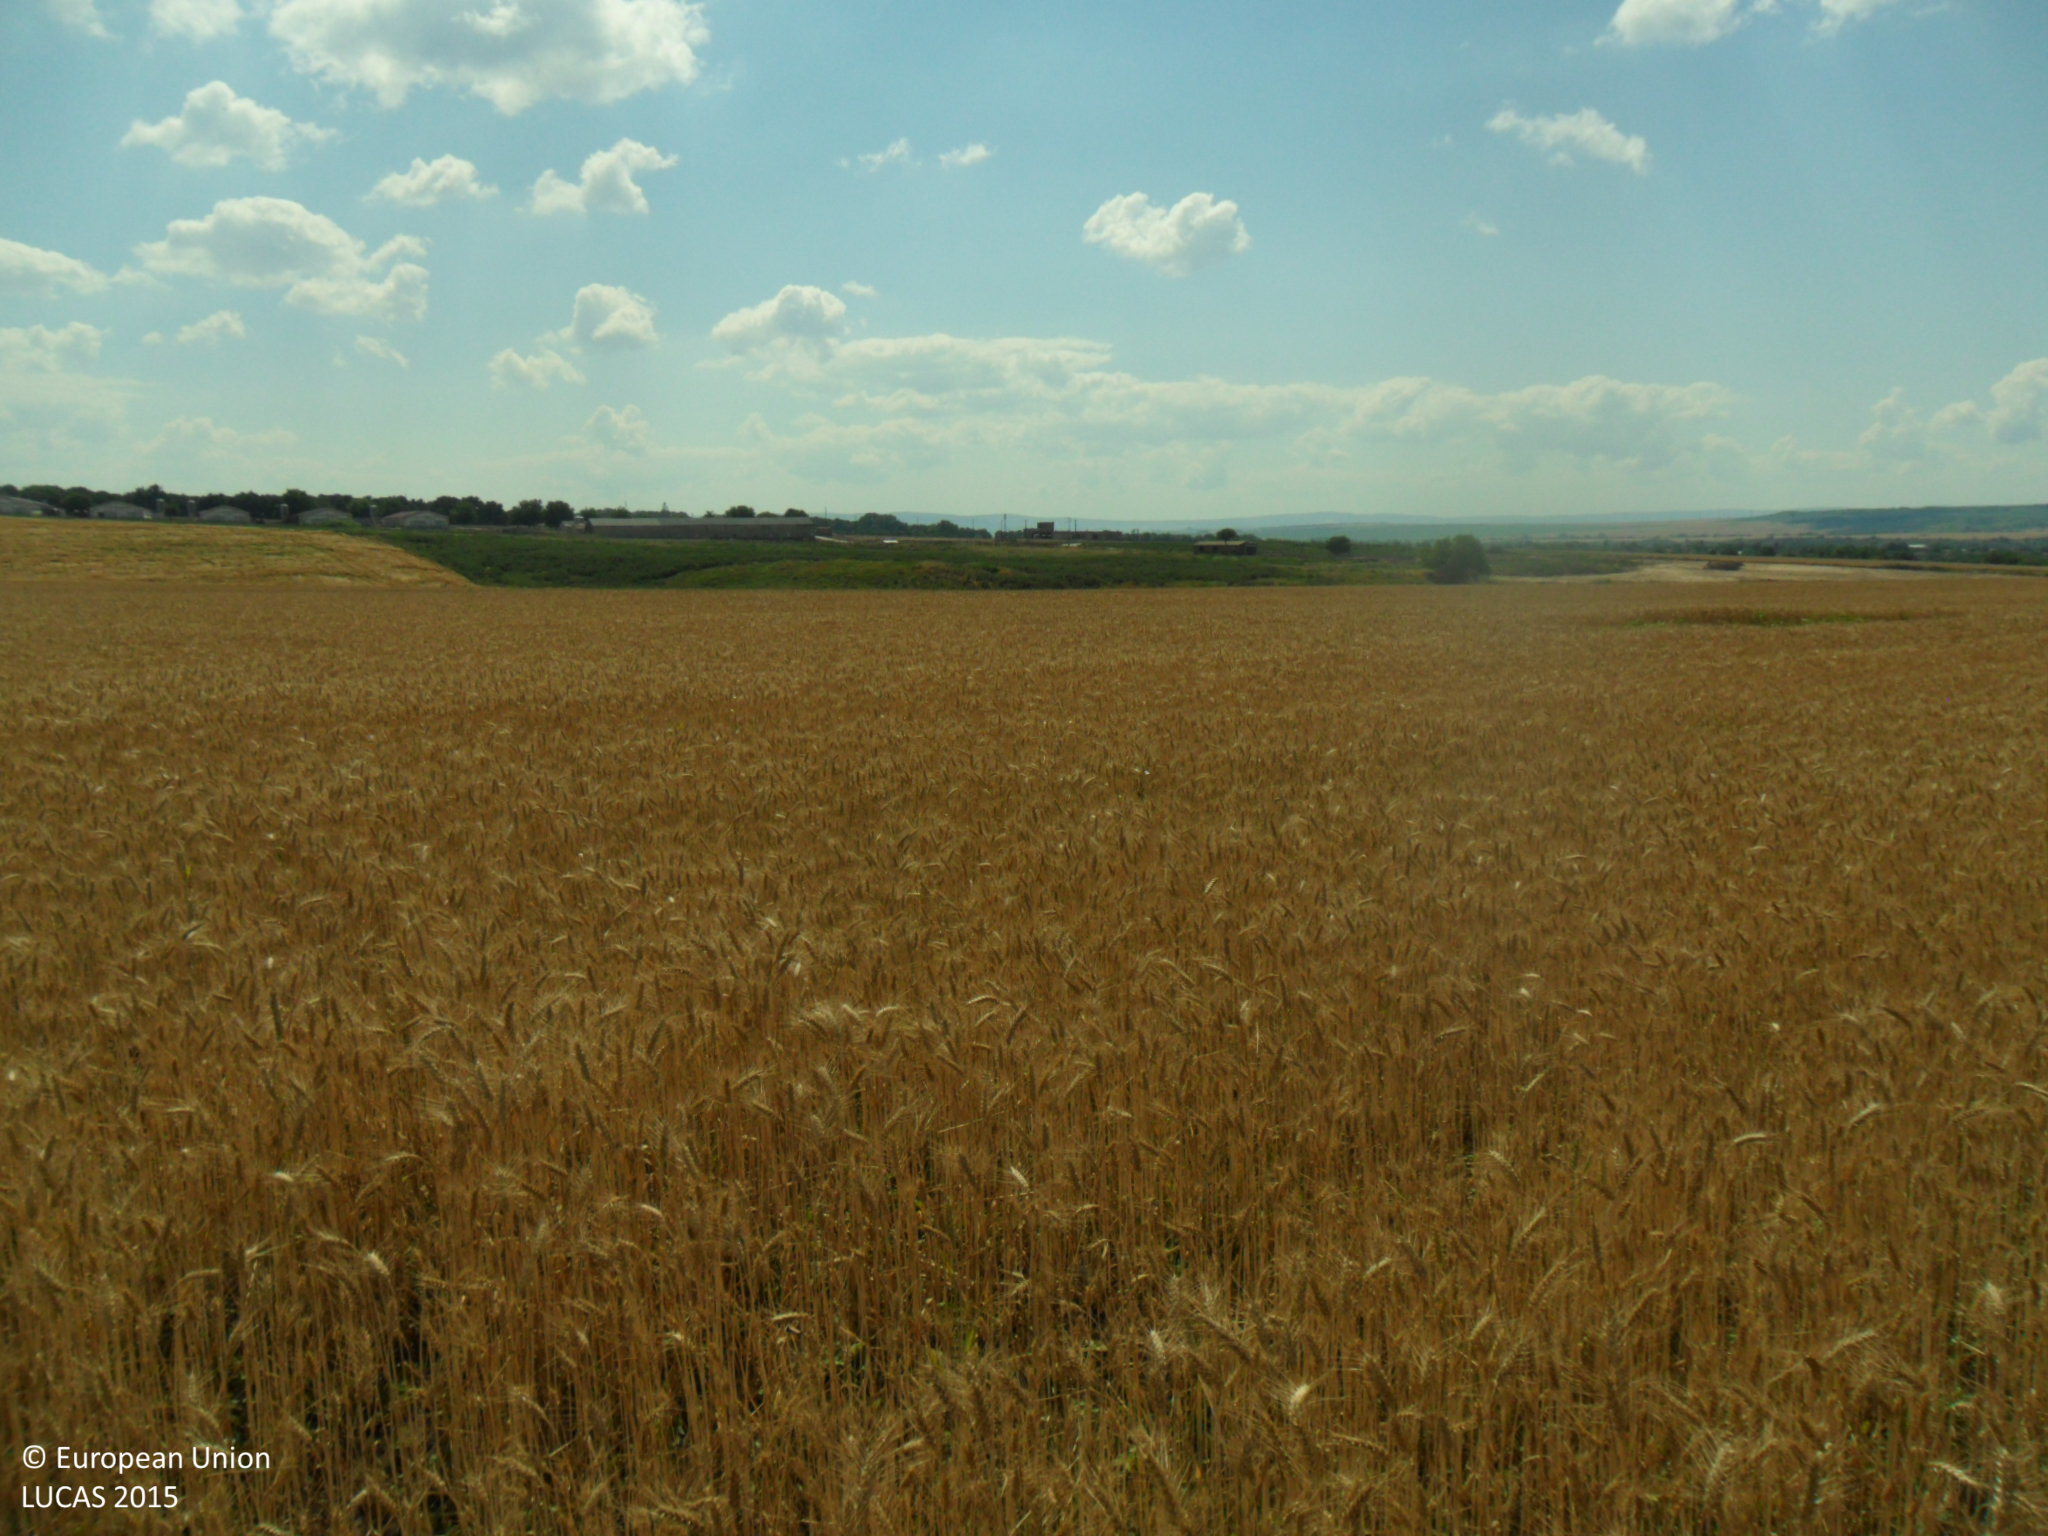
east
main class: Cropland
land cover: Common wheat
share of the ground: > 75 %
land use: Agriculture (excluding fallow land and kitchen gardens)
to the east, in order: Common wheat; Tracks; Common wheat
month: June
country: BG
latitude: 43.3560
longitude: 26.9054
